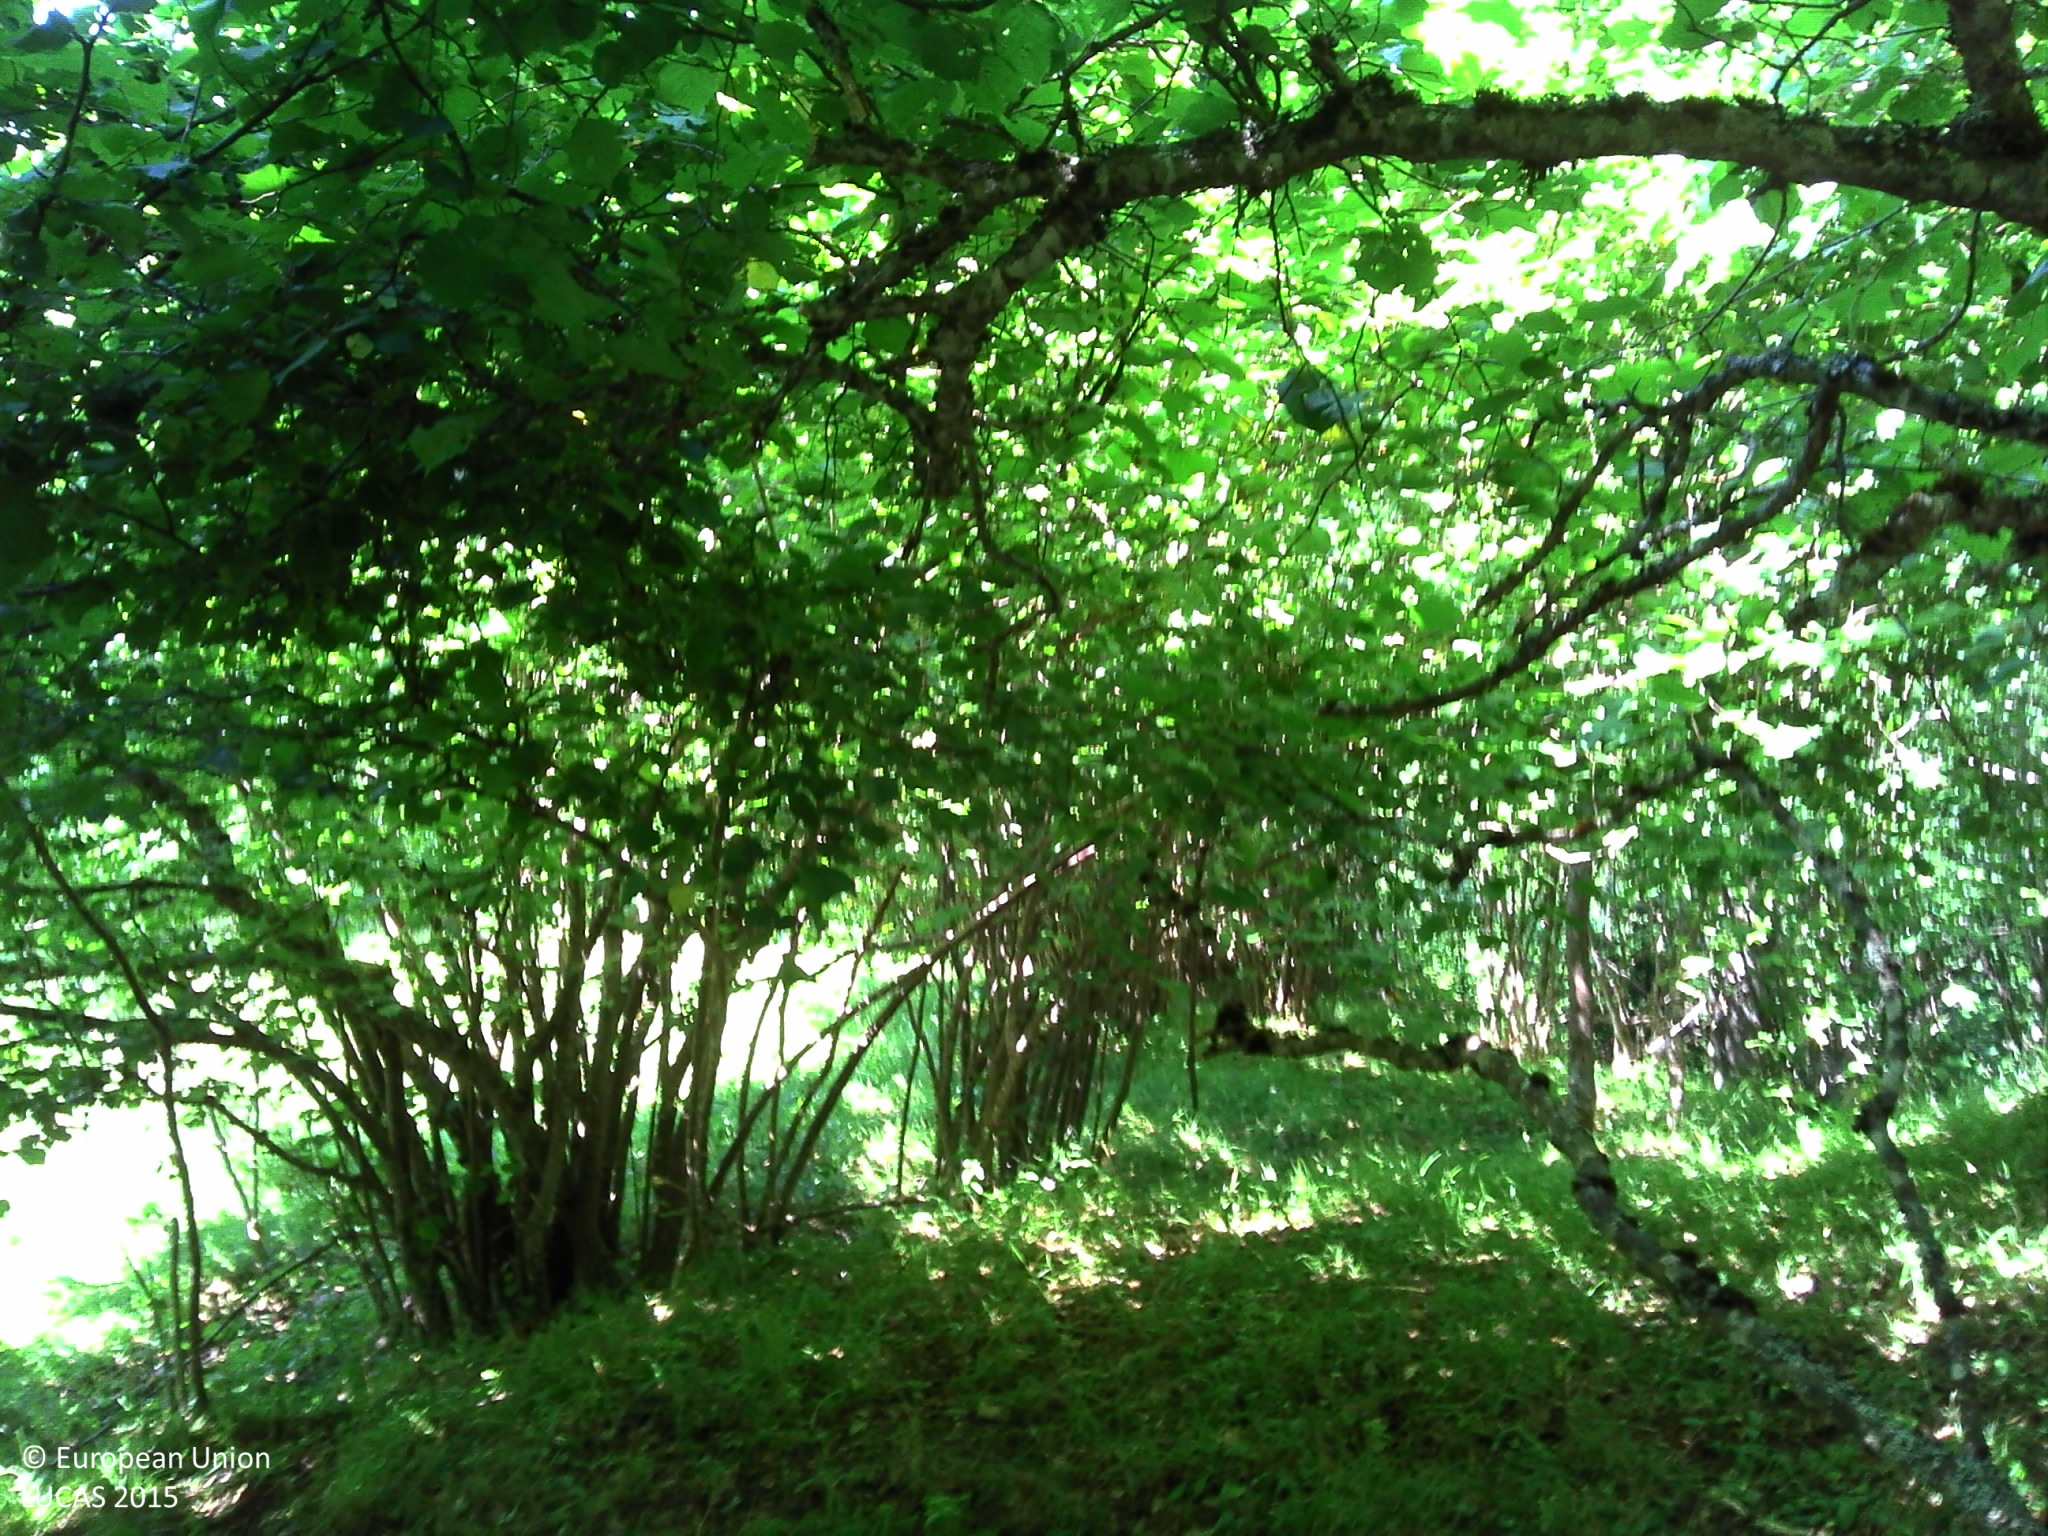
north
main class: Woodland
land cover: Broadleaved woodland
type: mesophytic deciduous forest
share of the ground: > 75 %
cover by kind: broadleaved forest trees 100 %
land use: Semi-natural and natural areas not in use
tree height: > 5 m
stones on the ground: < 10 %
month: July
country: FR
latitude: 42.6516
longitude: 1.8491
